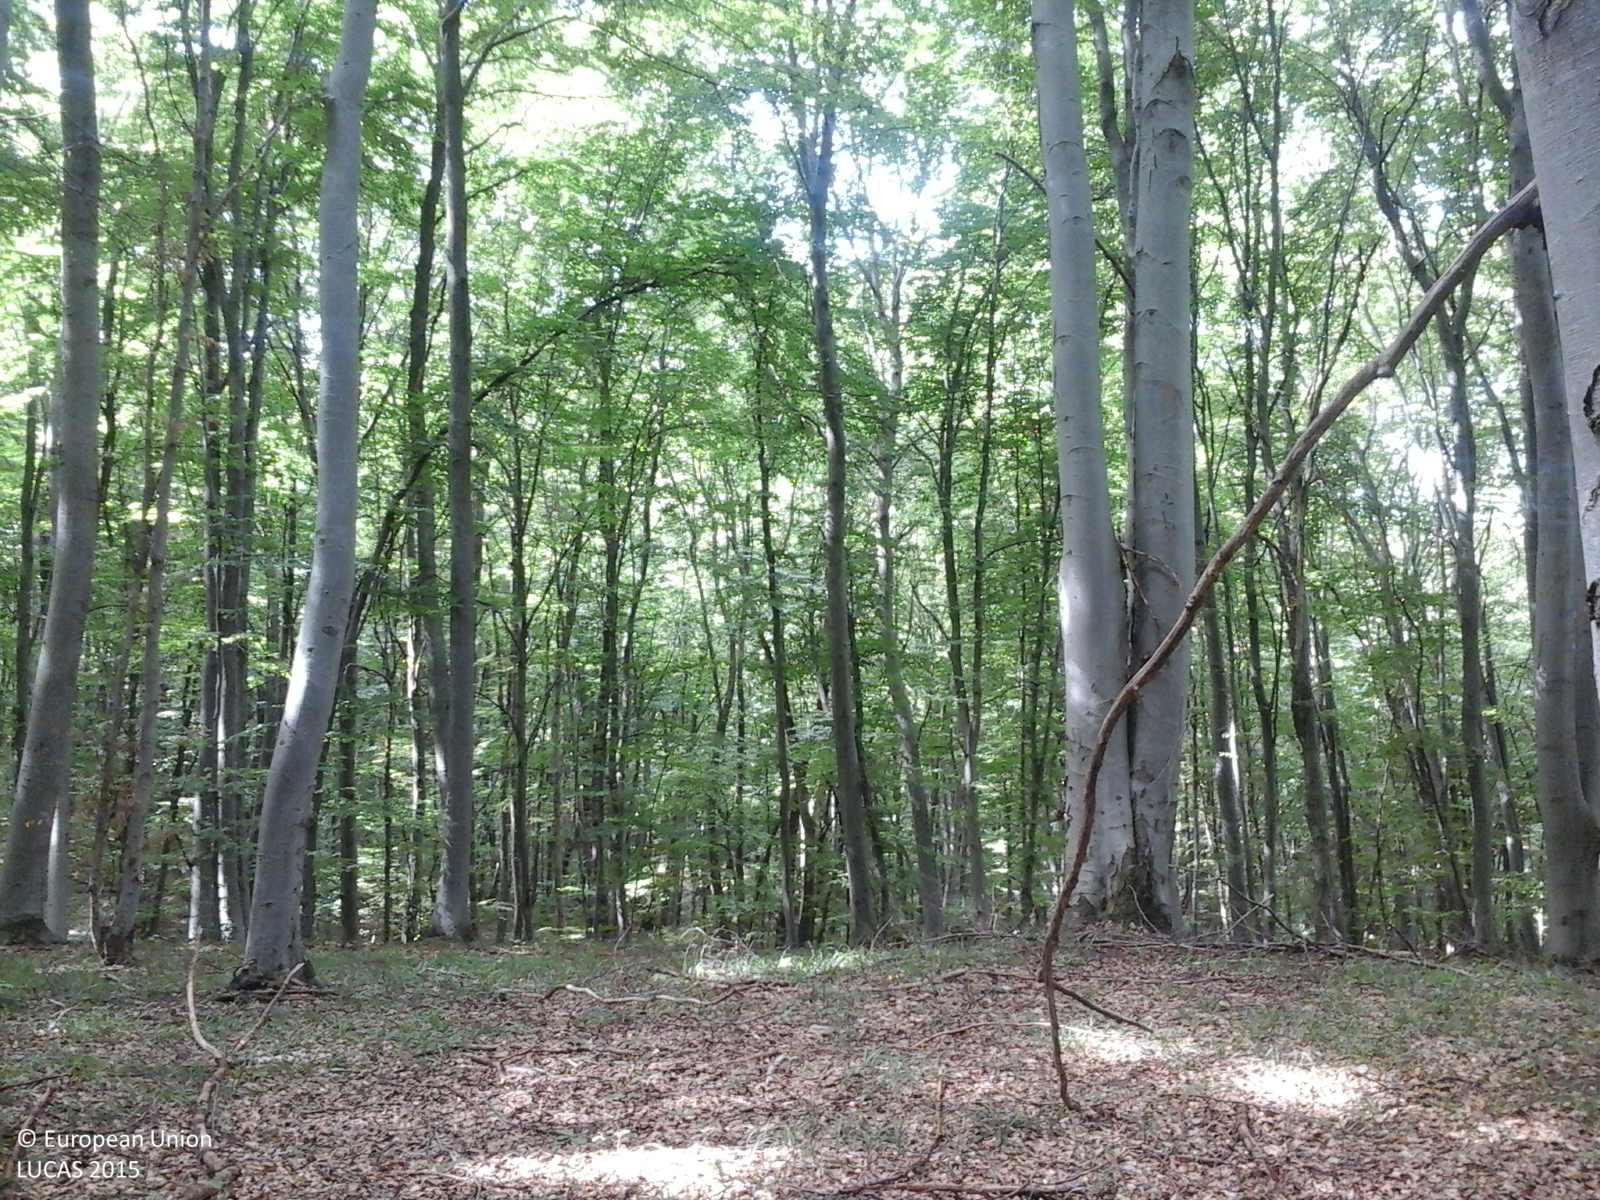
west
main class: Woodland
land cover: Broadleaved woodland
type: beech forest
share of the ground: > 75 %
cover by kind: broadleaved forest trees 100 %
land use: Forestry
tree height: > 5 m
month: September
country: RO
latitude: 46.7064
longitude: 23.5552
